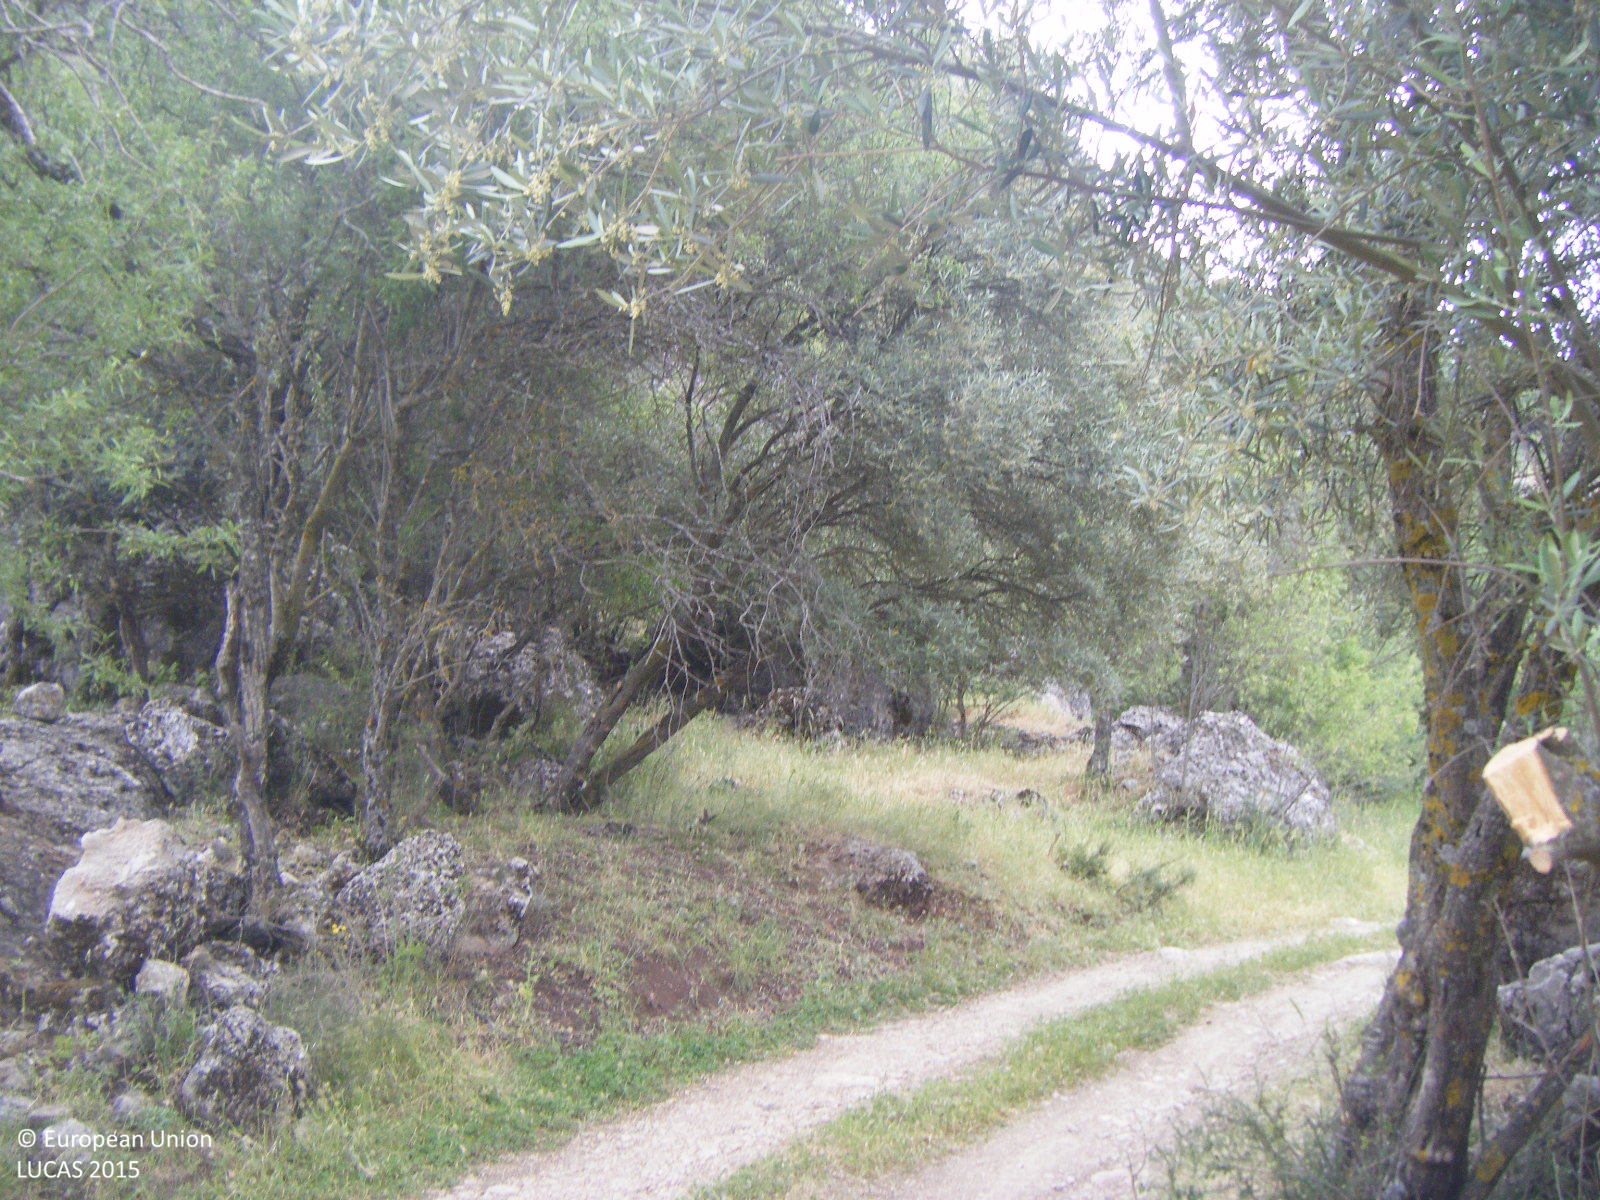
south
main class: Shrubland
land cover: Shrubland with sparse tree cover
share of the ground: 25 - 50 %
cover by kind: consolidated bare surface 35 %, shrubs 30 %, herbaceous plants 30 %, broadleaved forest trees 5 %
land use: Semi-natural and natural areas not in use
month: May
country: ES
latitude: 36.9787
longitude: -4.3846
